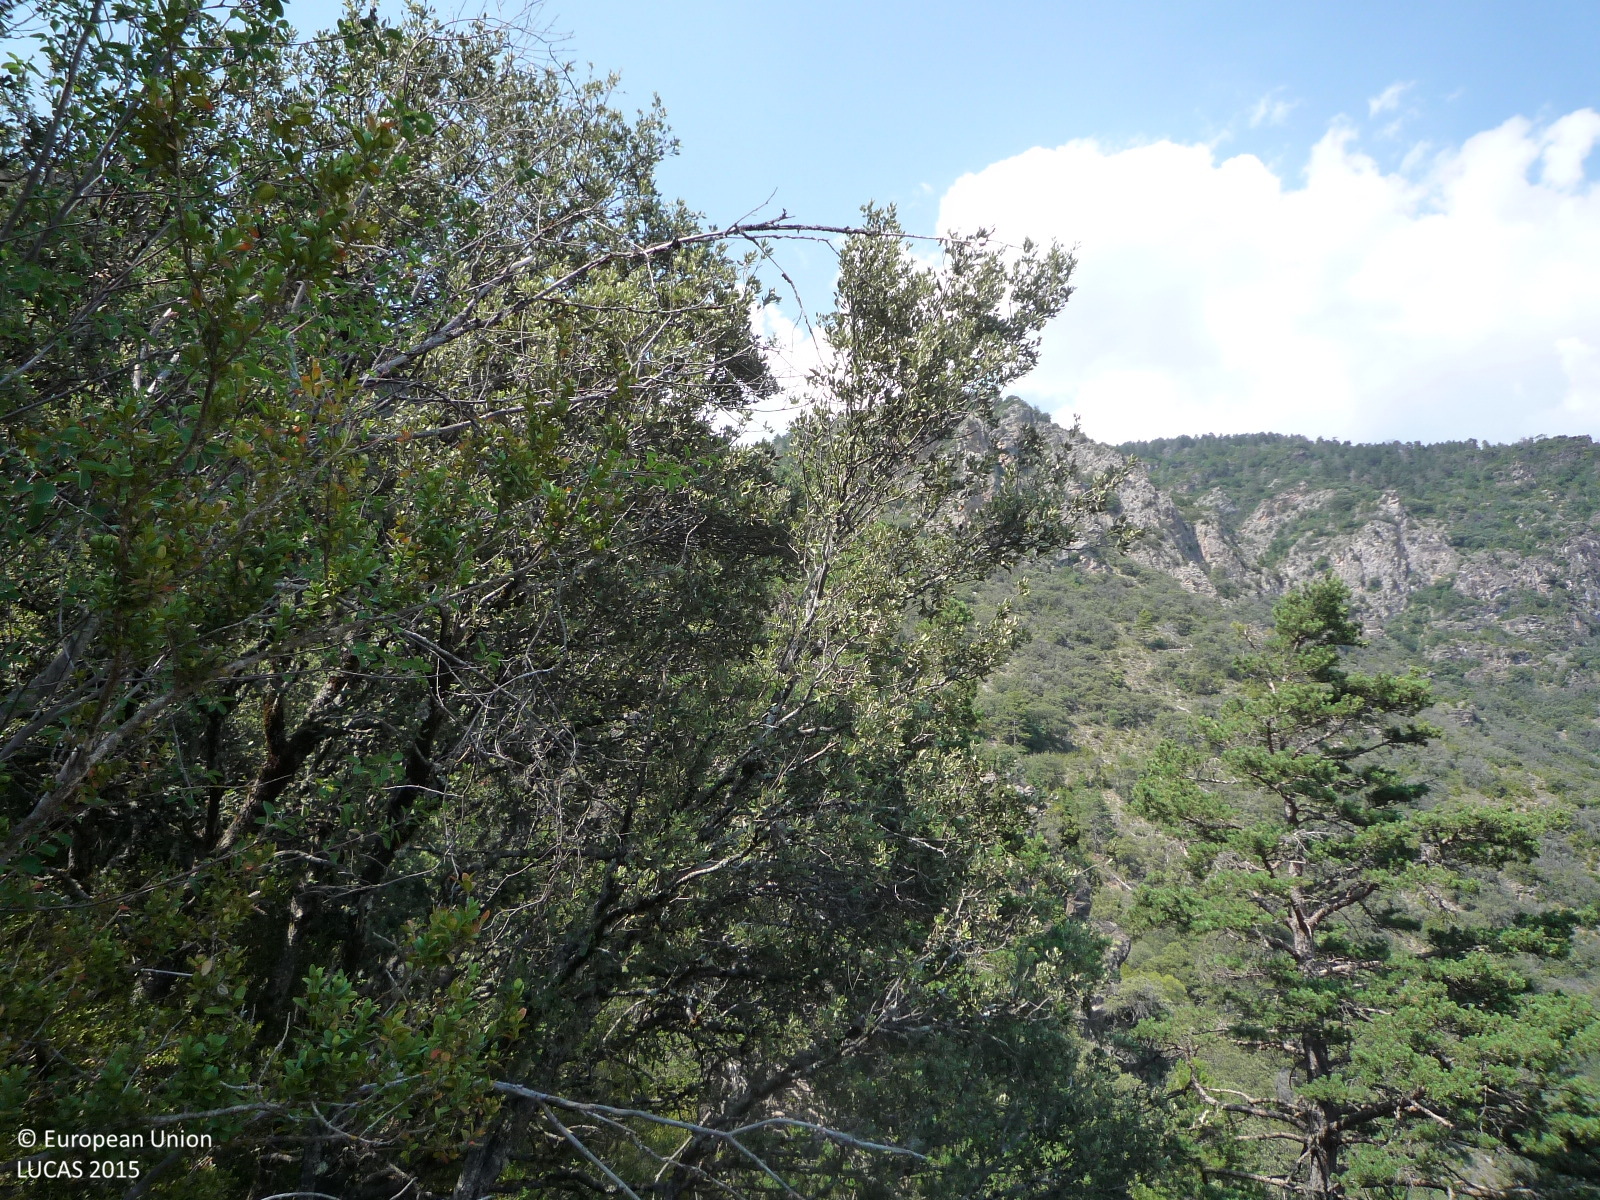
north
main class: Woodland
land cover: Pine dominated mixed woodland
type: alpine coniferous forest
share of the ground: > 75 %
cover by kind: broadleaved forest trees 40 %, coniferous forest trees 30 %, shrubs 20 %, consolidated bare surface 10 %
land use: Semi-natural and natural areas not in use
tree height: < 5 m
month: June
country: ES
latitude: 42.3767
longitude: 1.5941
